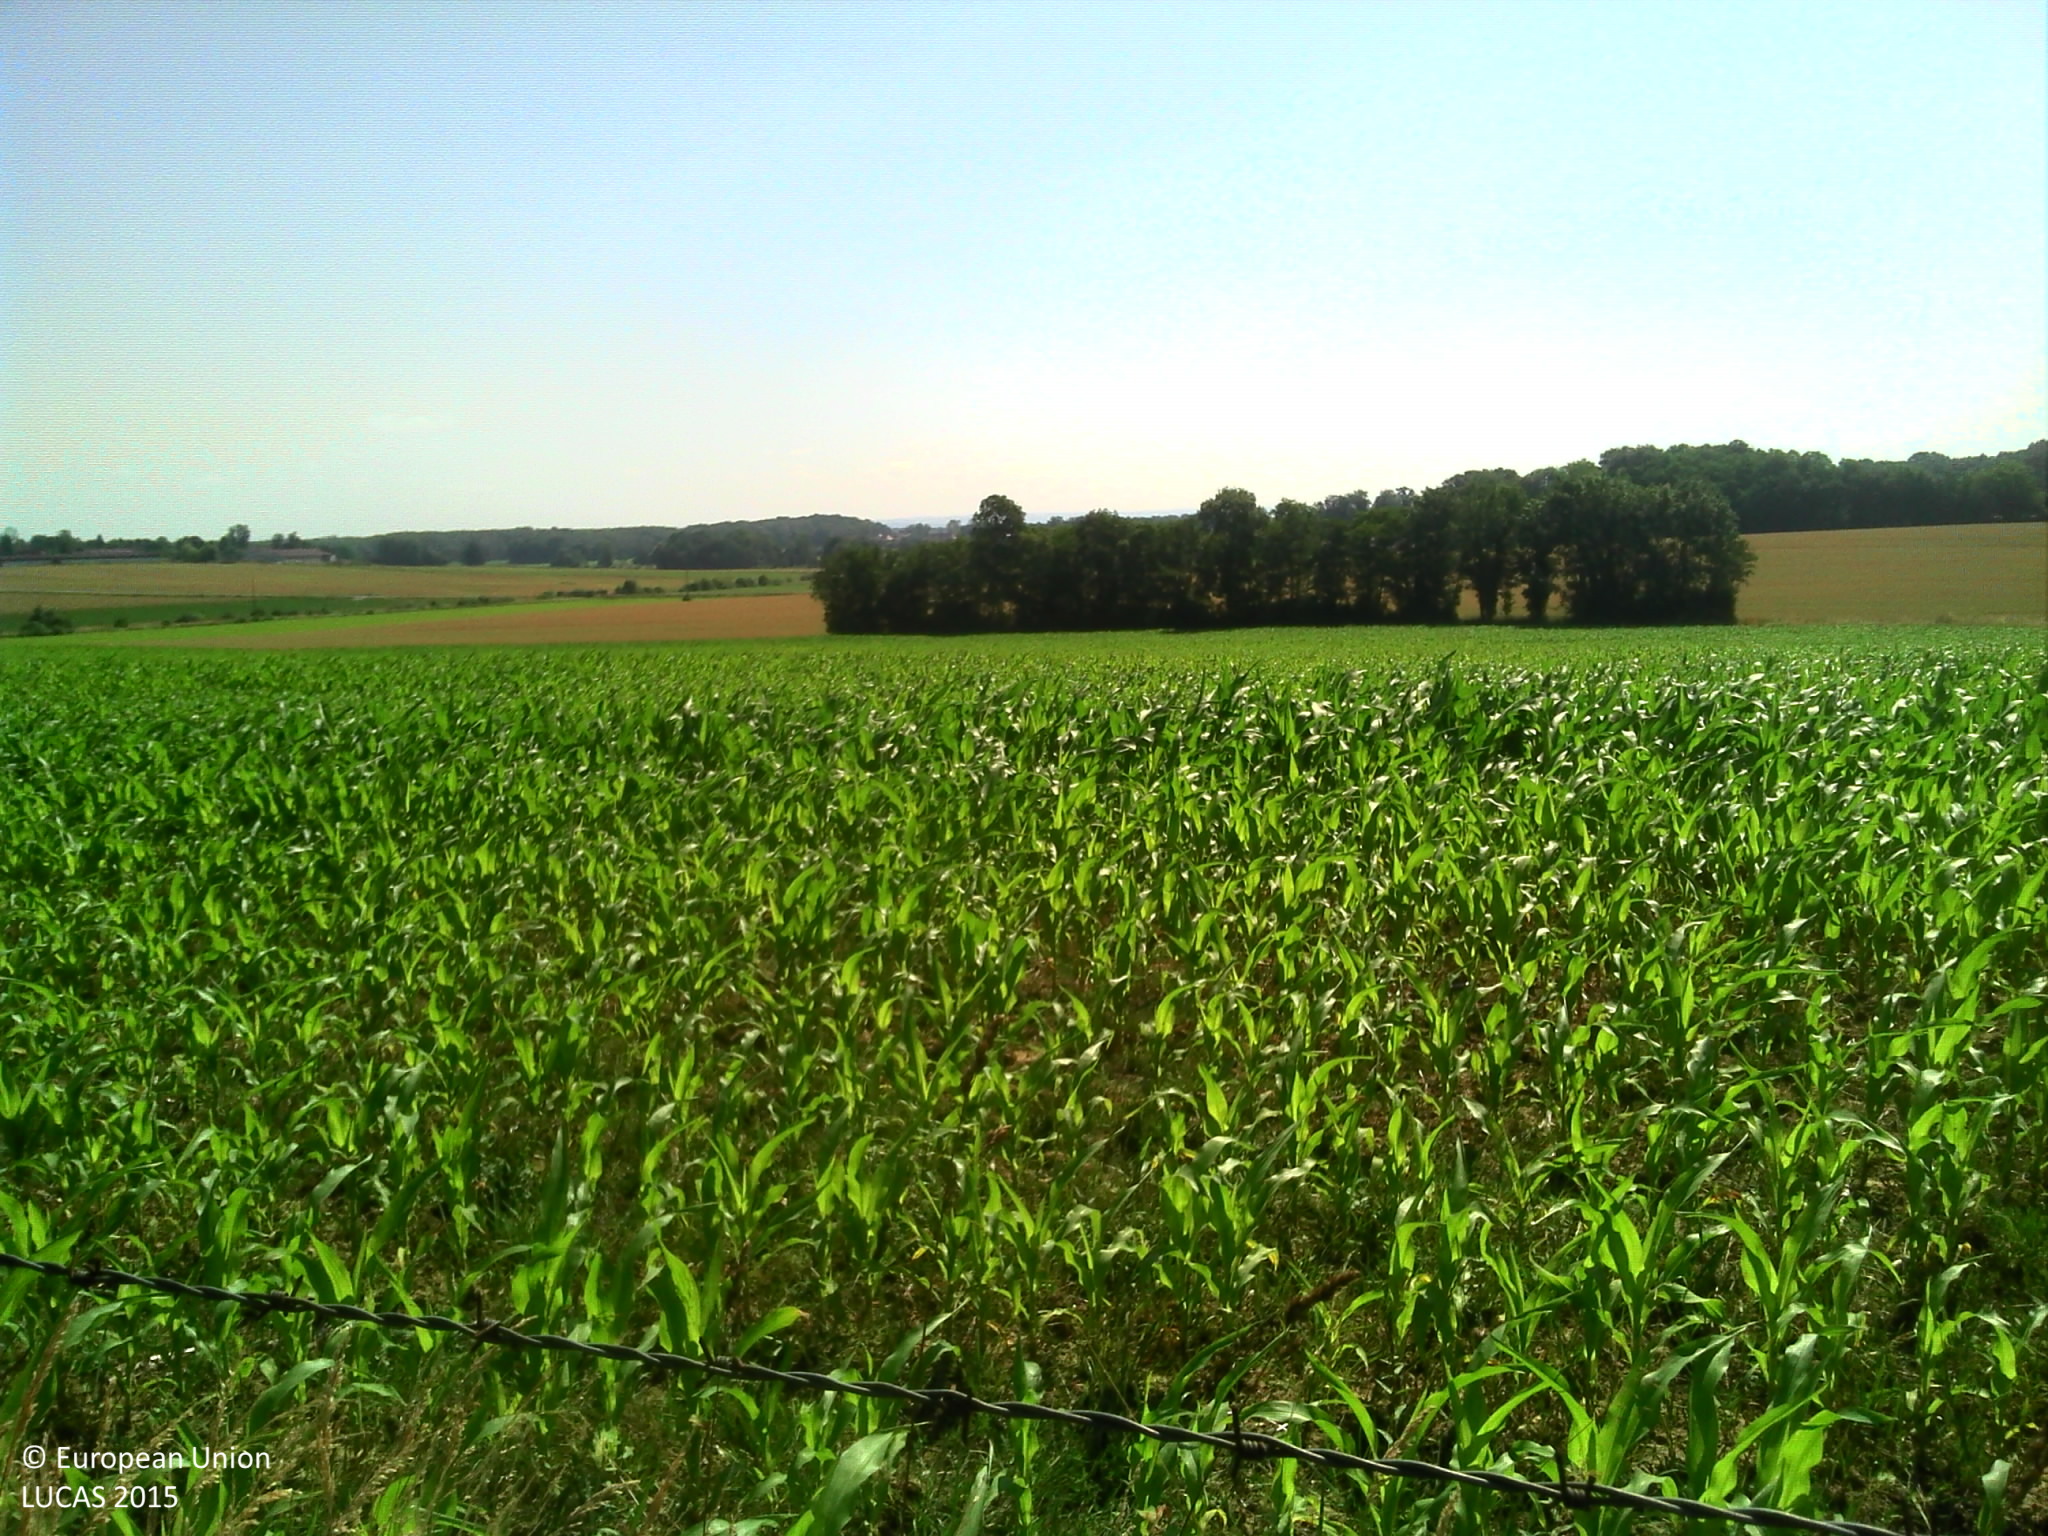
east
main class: Grassland
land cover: Grassland without tree/shrub cover
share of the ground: > 75 %
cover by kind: herbaceous plants 100 %
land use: Agriculture (excluding fallow land and kitchen gardens)
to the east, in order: Fences; Maize; Ditches and canals; Broadleaved woodland; Common wheat
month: June
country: FR
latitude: 46.7543
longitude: 5.3284
